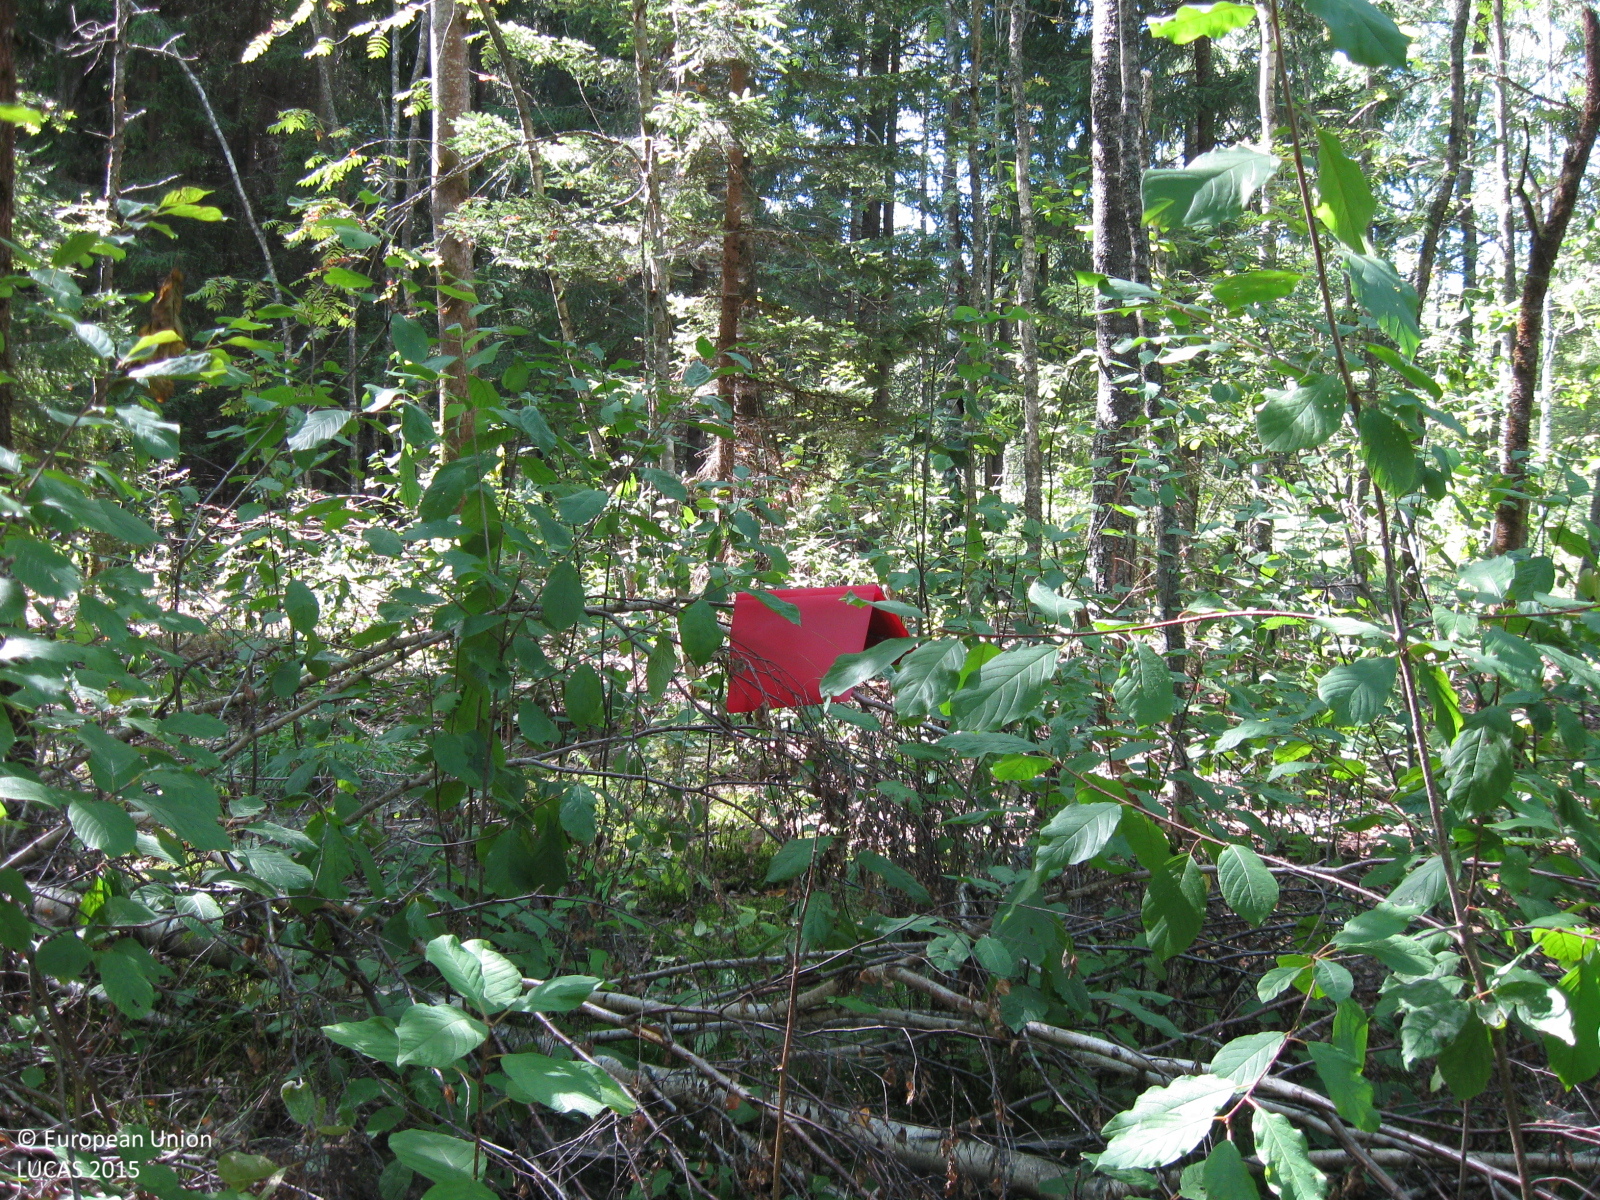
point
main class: Woodland
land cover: Other mixed woodland
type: hemiboreal forest and nemoral coniferous forest and mixed broadleaved-coniferous forest
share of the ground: > 75 %
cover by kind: broadleaved forest trees 65 %, coniferous forest trees 30 %, herbaceous plants 5 %
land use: Forestry
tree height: > 5 m
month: August
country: LT
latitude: 55.5838
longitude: 22.5791
